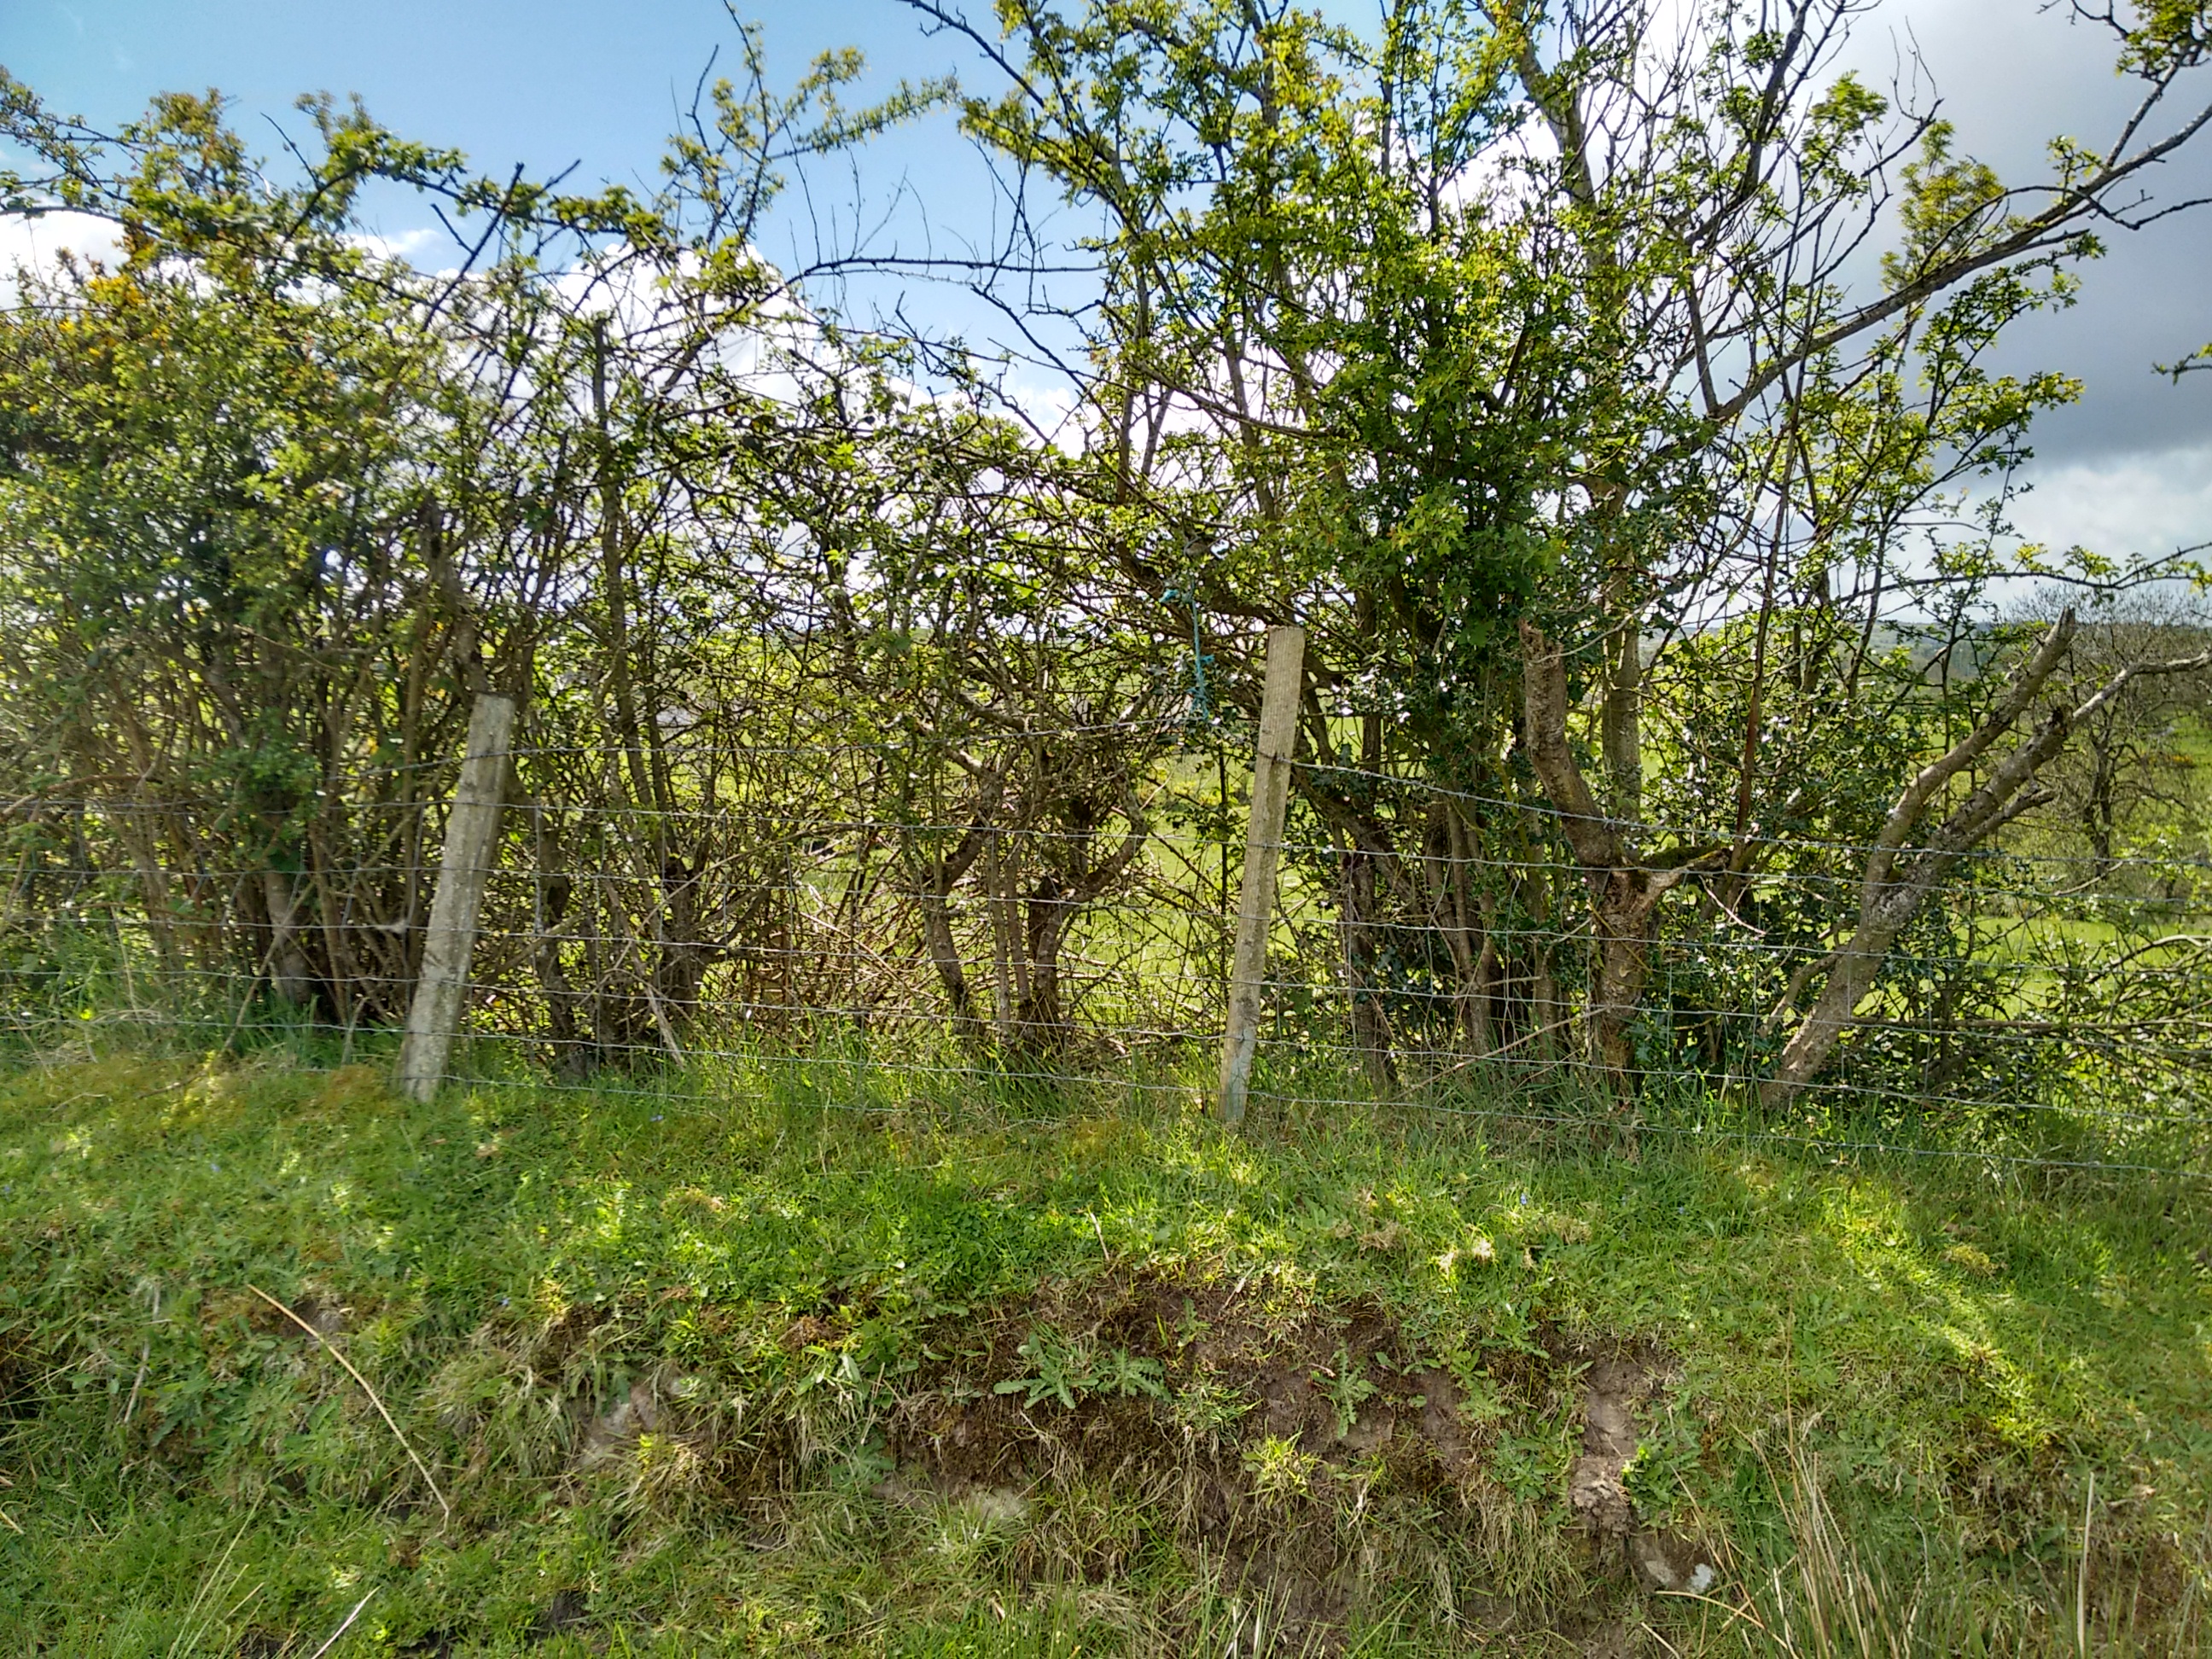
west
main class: Grassland
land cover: Grassland without tree/shrub cover
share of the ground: > 75 %
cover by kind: herbaceous plants 100 %
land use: Agriculture (excluding fallow land and kitchen gardens)
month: May
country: GB
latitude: 54.9119
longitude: -7.1294
